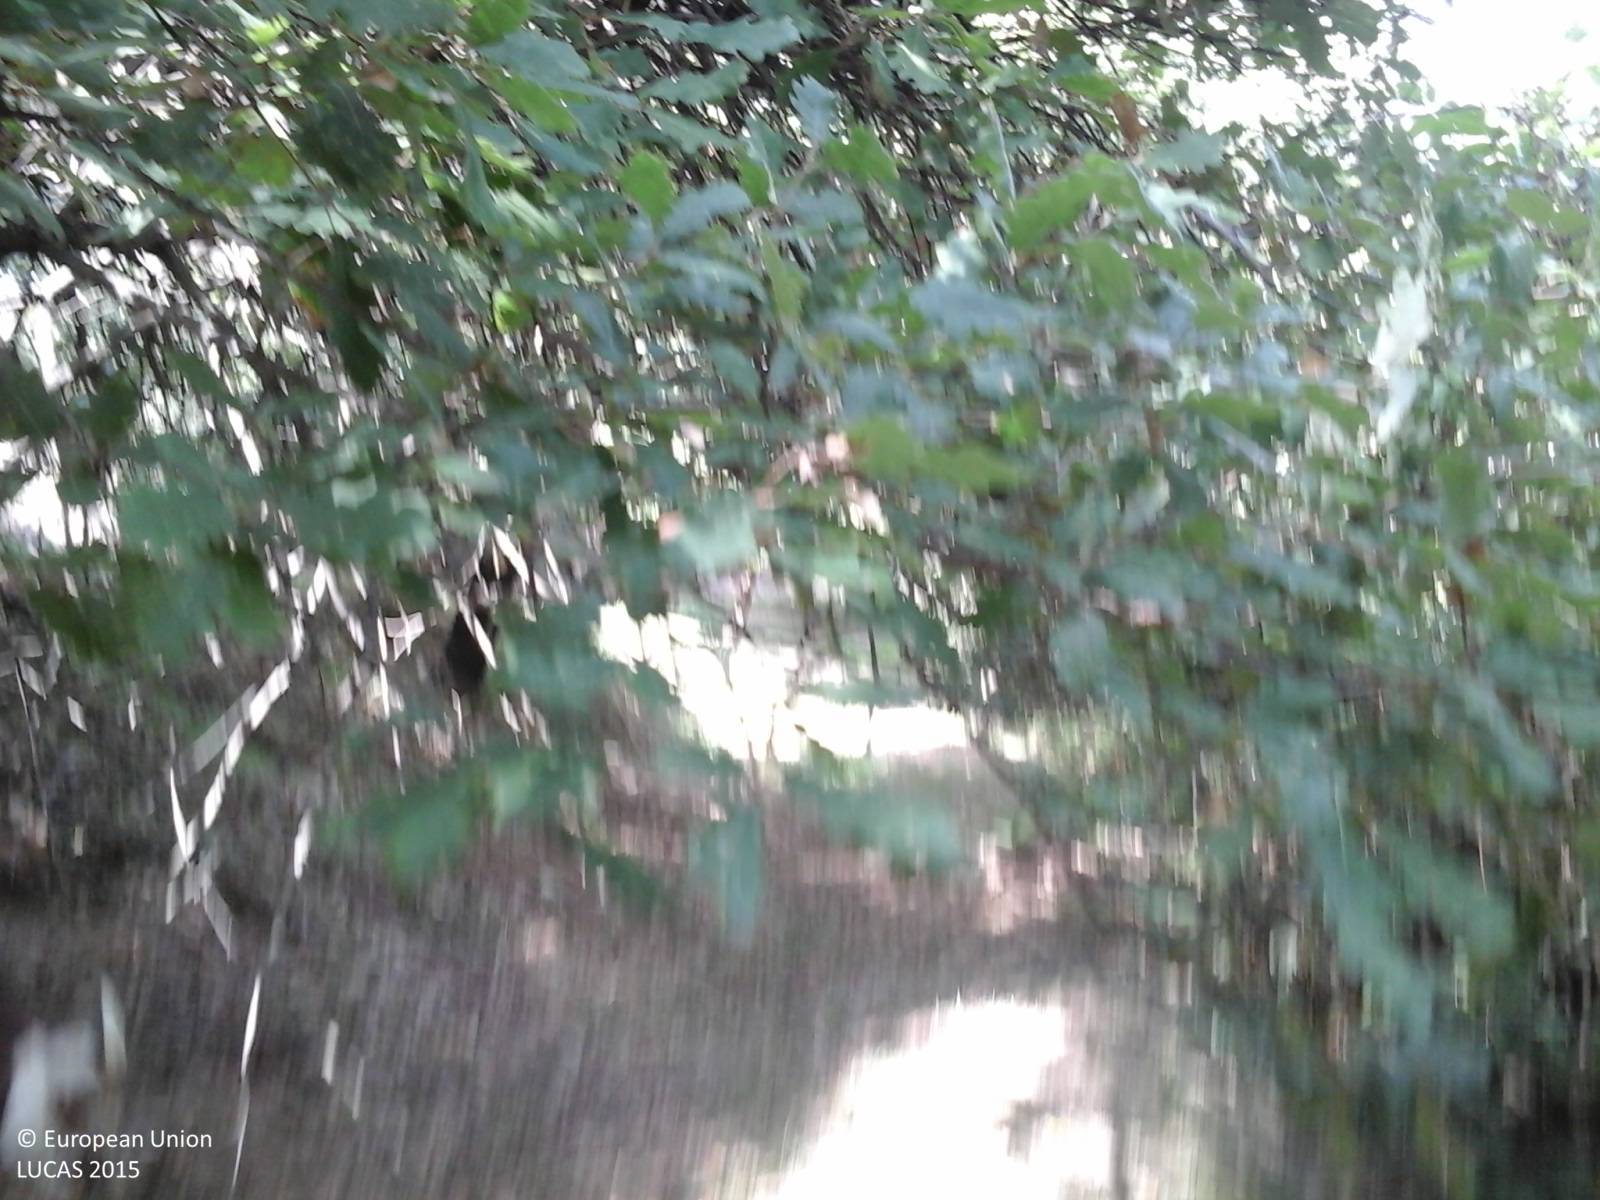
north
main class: Woodland
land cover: Broadleaved woodland
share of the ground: 50 - 75 %
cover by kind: broadleaved forest trees 70 %, shrubs 30 %
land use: Forestry
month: September
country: IT
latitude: 43.0298
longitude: 12.0924
